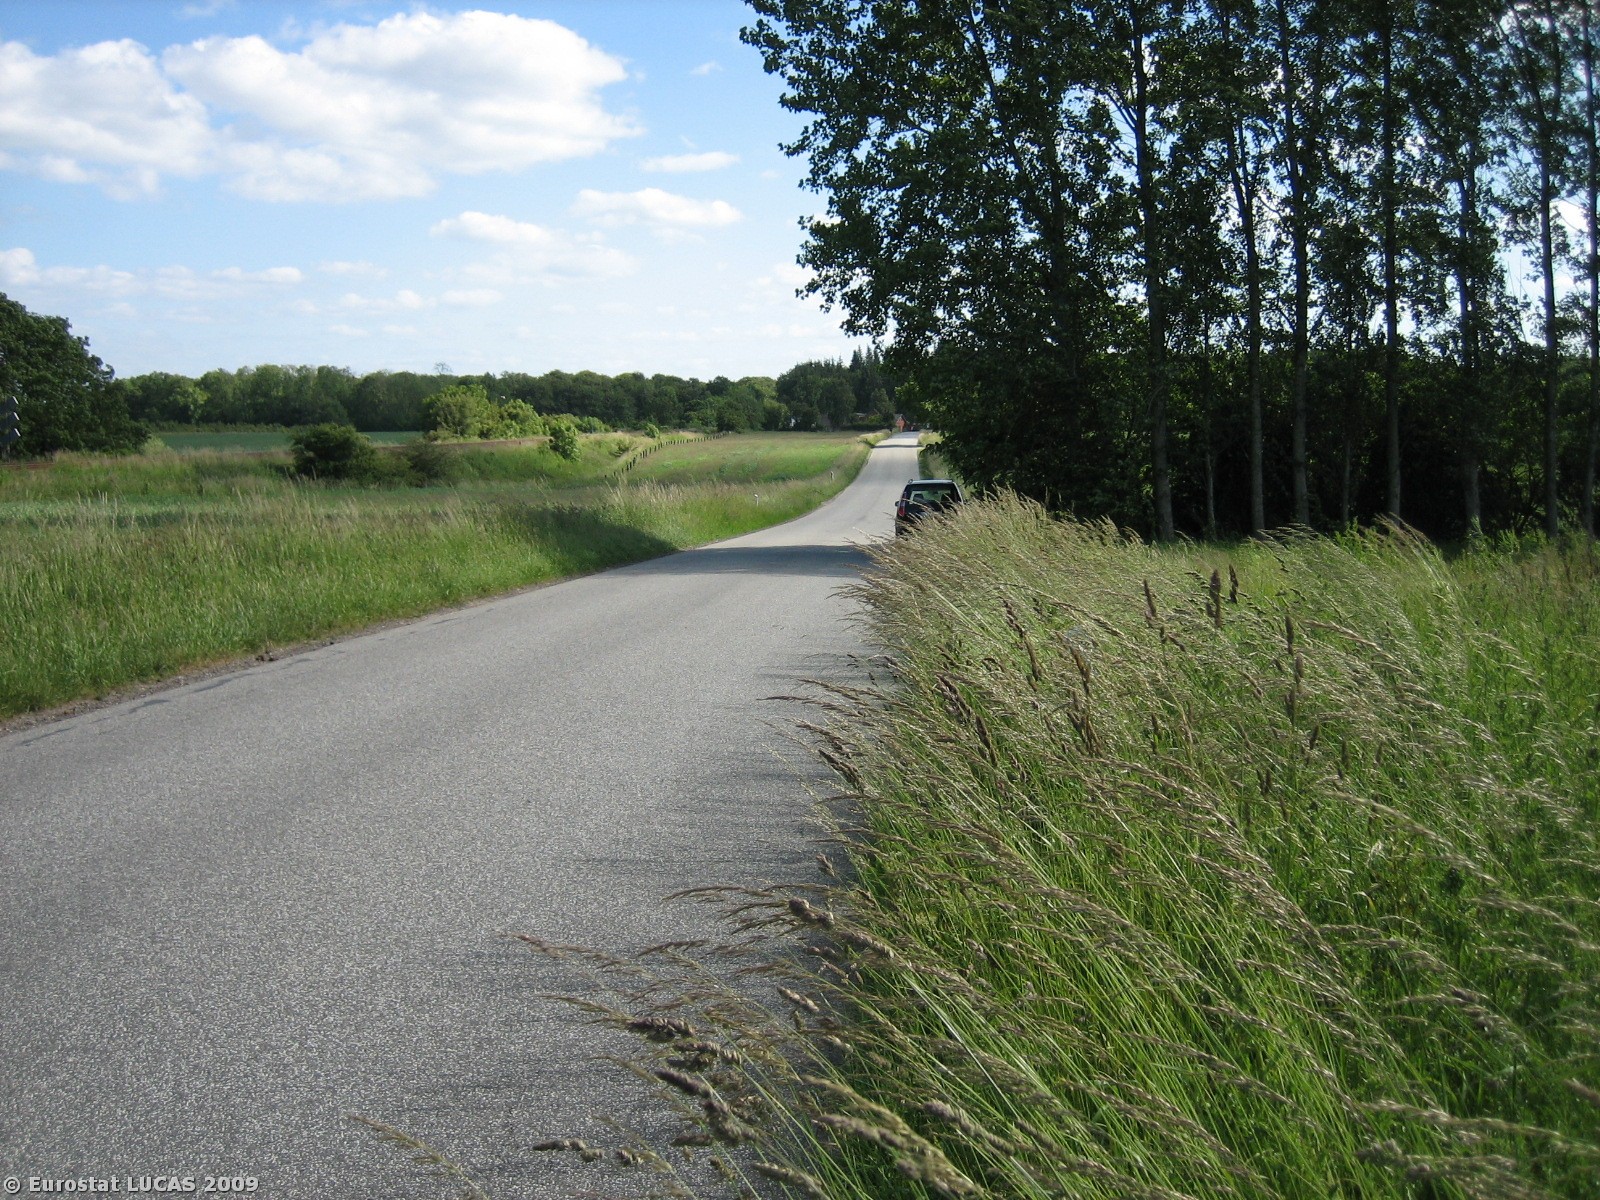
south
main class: Grassland
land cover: Grassland without tree/shrub cover
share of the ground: > 75 %
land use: Unused
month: June
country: DK
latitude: 55.7560
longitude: 9.6976
